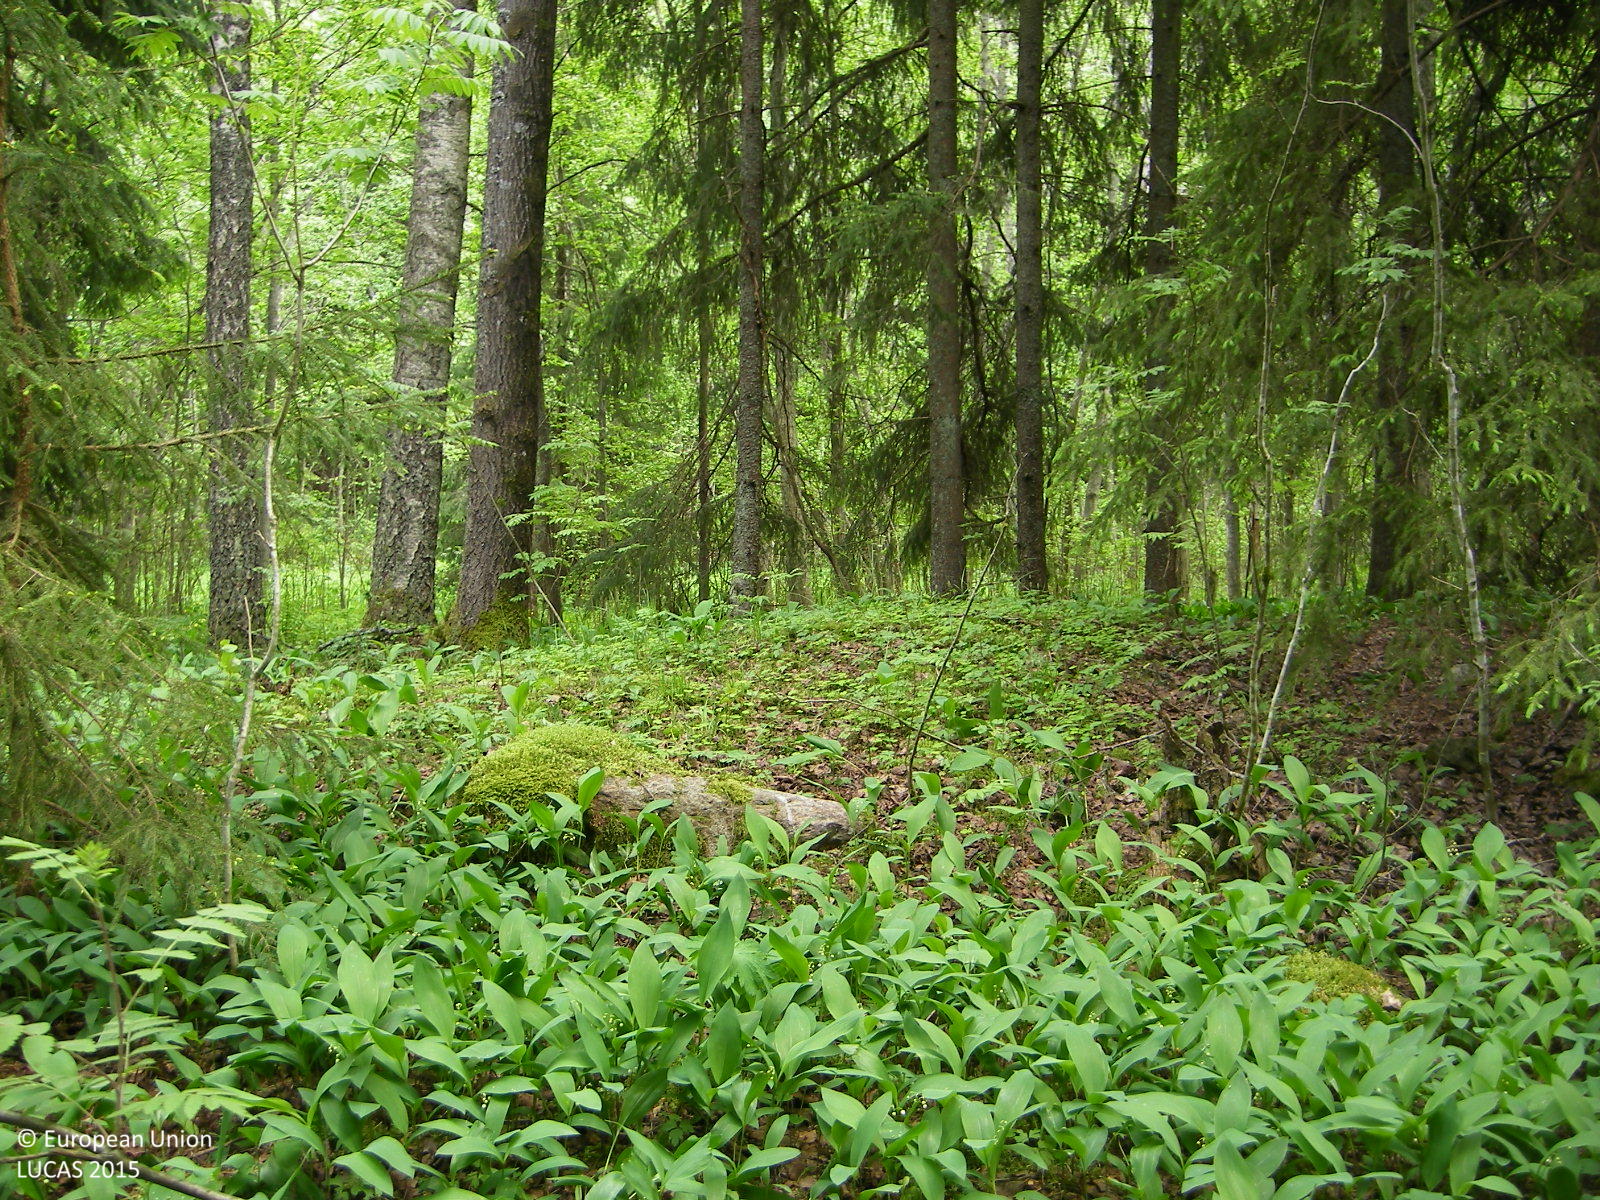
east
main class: Woodland
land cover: Spruce dominated mixed woodland
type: boreal forest
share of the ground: > 75 %
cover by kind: broadleaved forest trees 50 %, coniferous forest trees 40 %, herbaceous plants 10 %
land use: Semi-natural and natural areas not in use
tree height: > 5 m
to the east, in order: Spruce dominated mixed woodland; Other mixed woodland; Spruce dominated mixed woodland; Spruce dominated coniferous woodland; Tracks; Electric lines; Spruce dominated mixed woodland
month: June
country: FI
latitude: 60.1935
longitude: 24.7037
